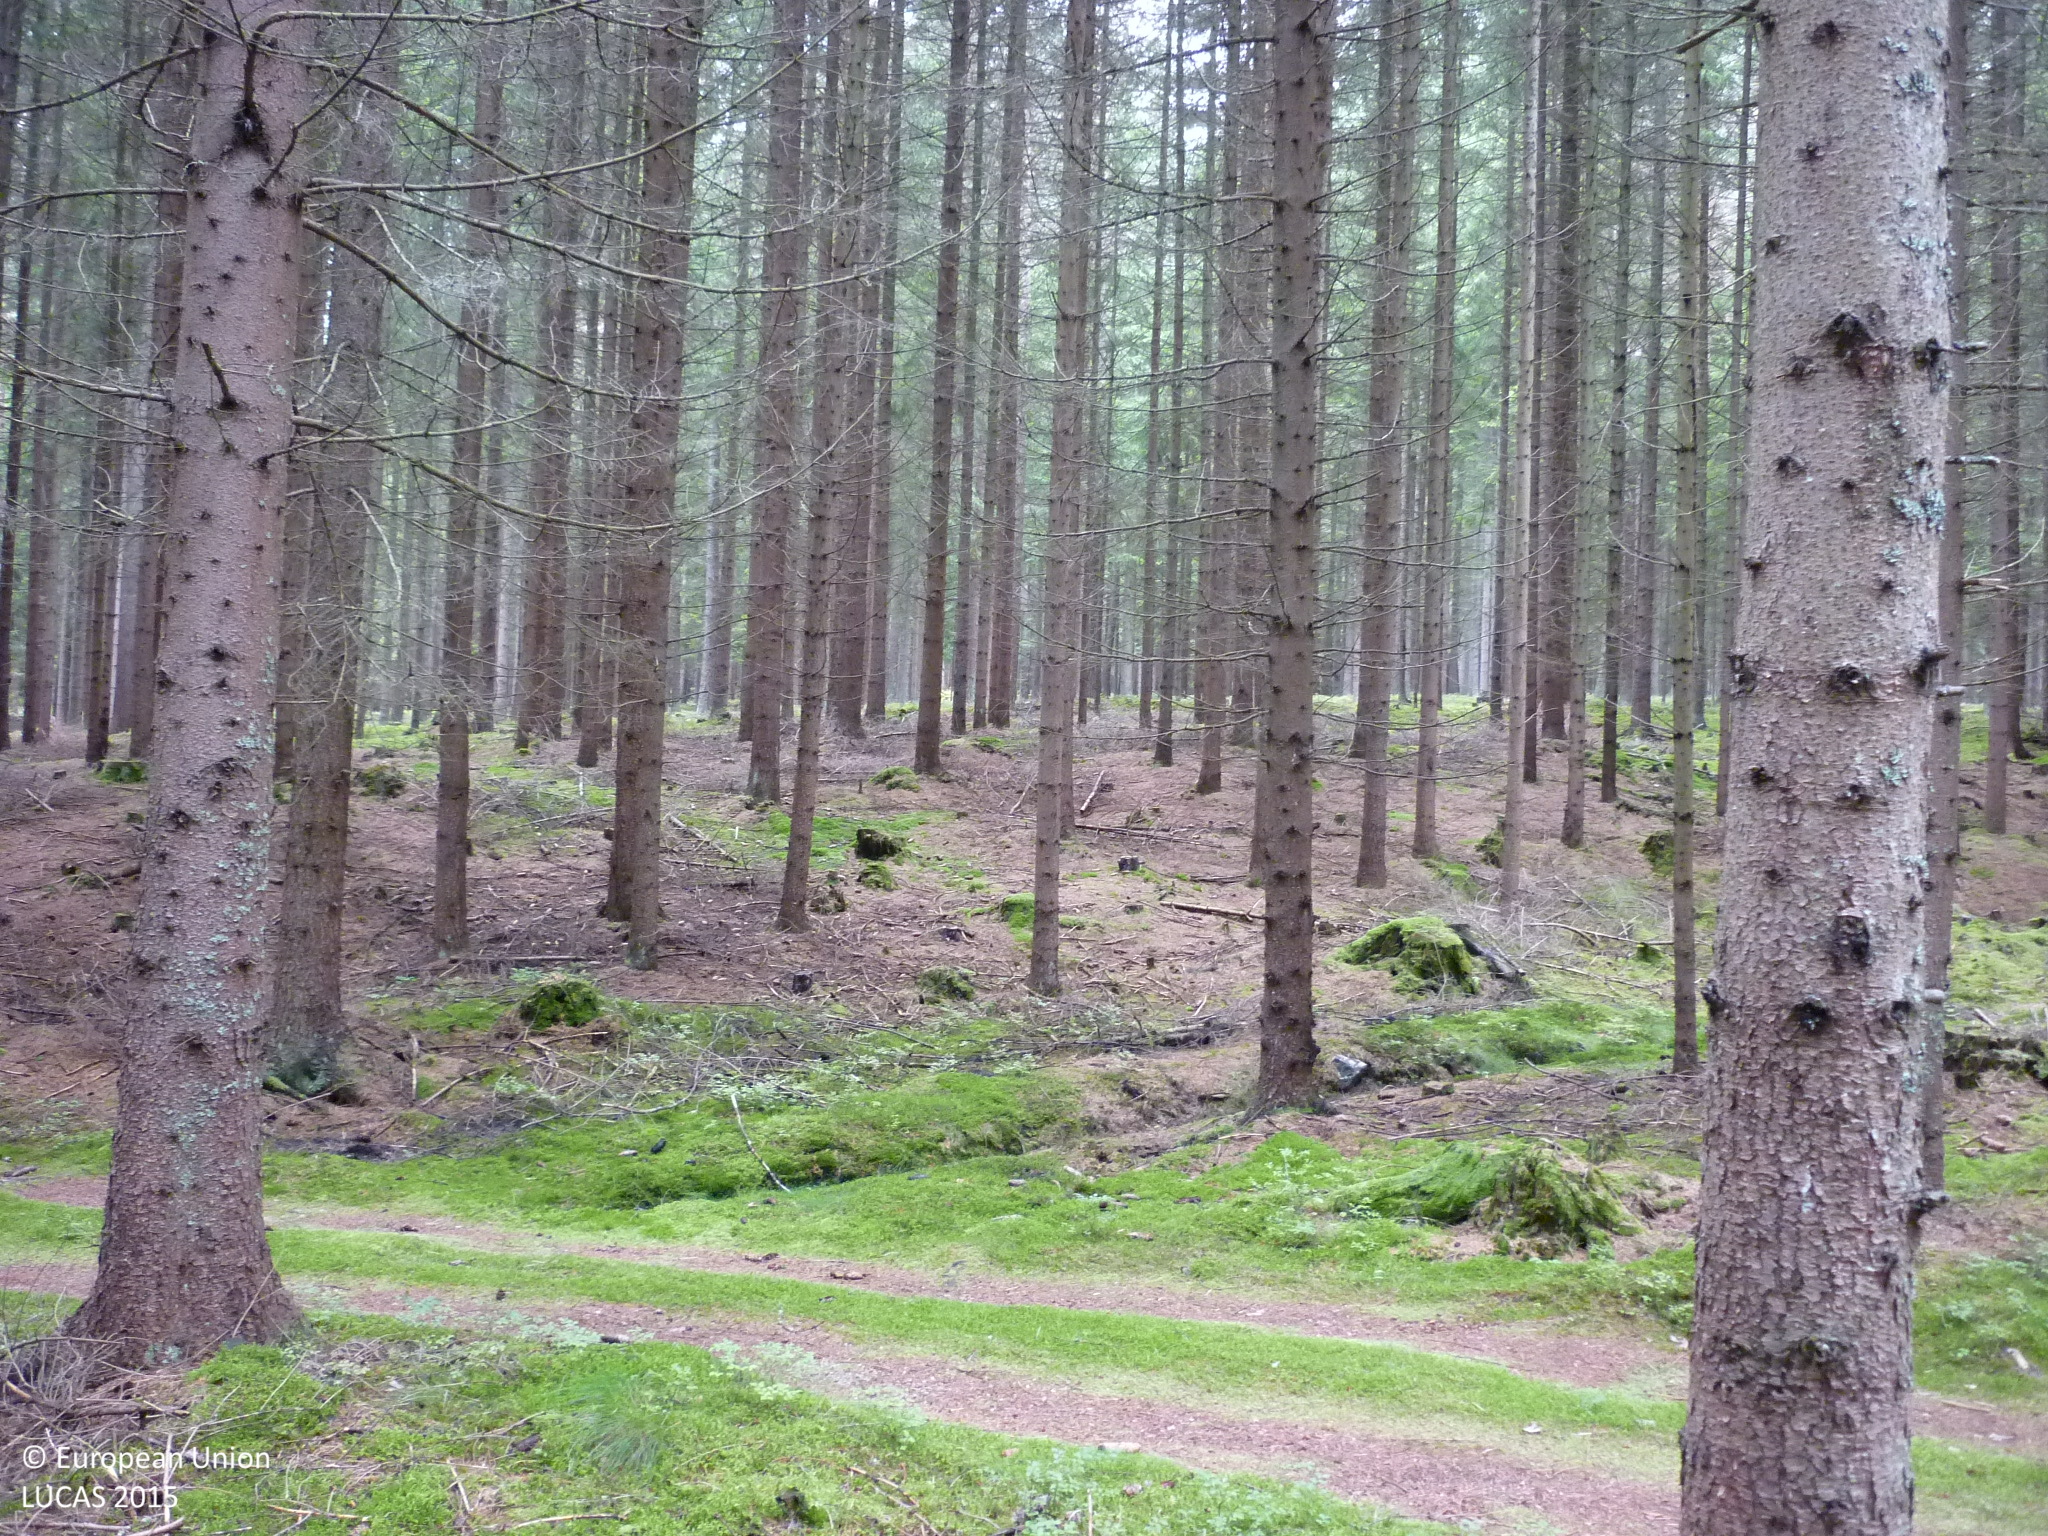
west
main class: Woodland
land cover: Spruce dominated coniferous woodland
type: hemiboreal forest and nemoral coniferous forest and mixed broadleaved-coniferous forest
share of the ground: > 75 %
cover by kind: coniferous forest trees 95 %, lichens and mosses 5 %
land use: Forestry
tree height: > 5 m
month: September
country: AT
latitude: 48.8646
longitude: 15.0595
